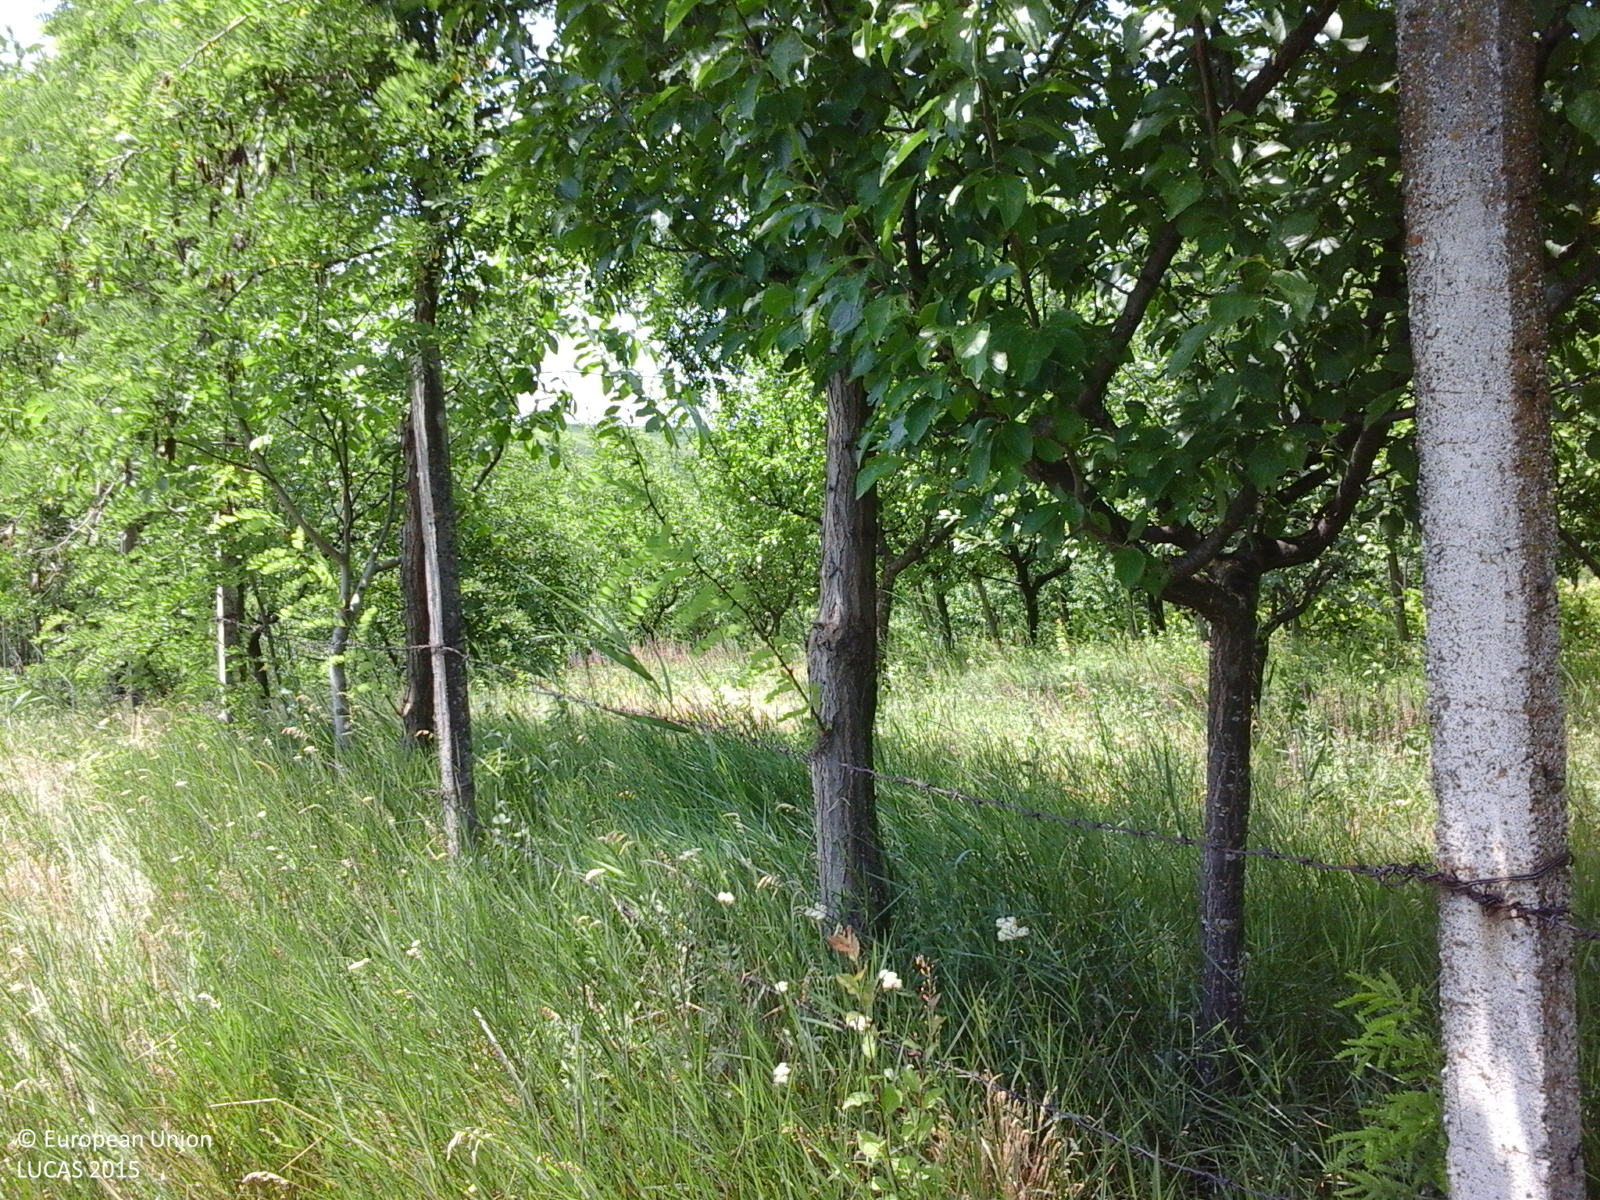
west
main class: Cropland
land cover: Vineyards
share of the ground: > 75 %
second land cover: Other bare soil
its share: > 75 %
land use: Agriculture (excluding fallow land and kitchen gardens)
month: June
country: RO
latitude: 47.2050
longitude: 27.6663
